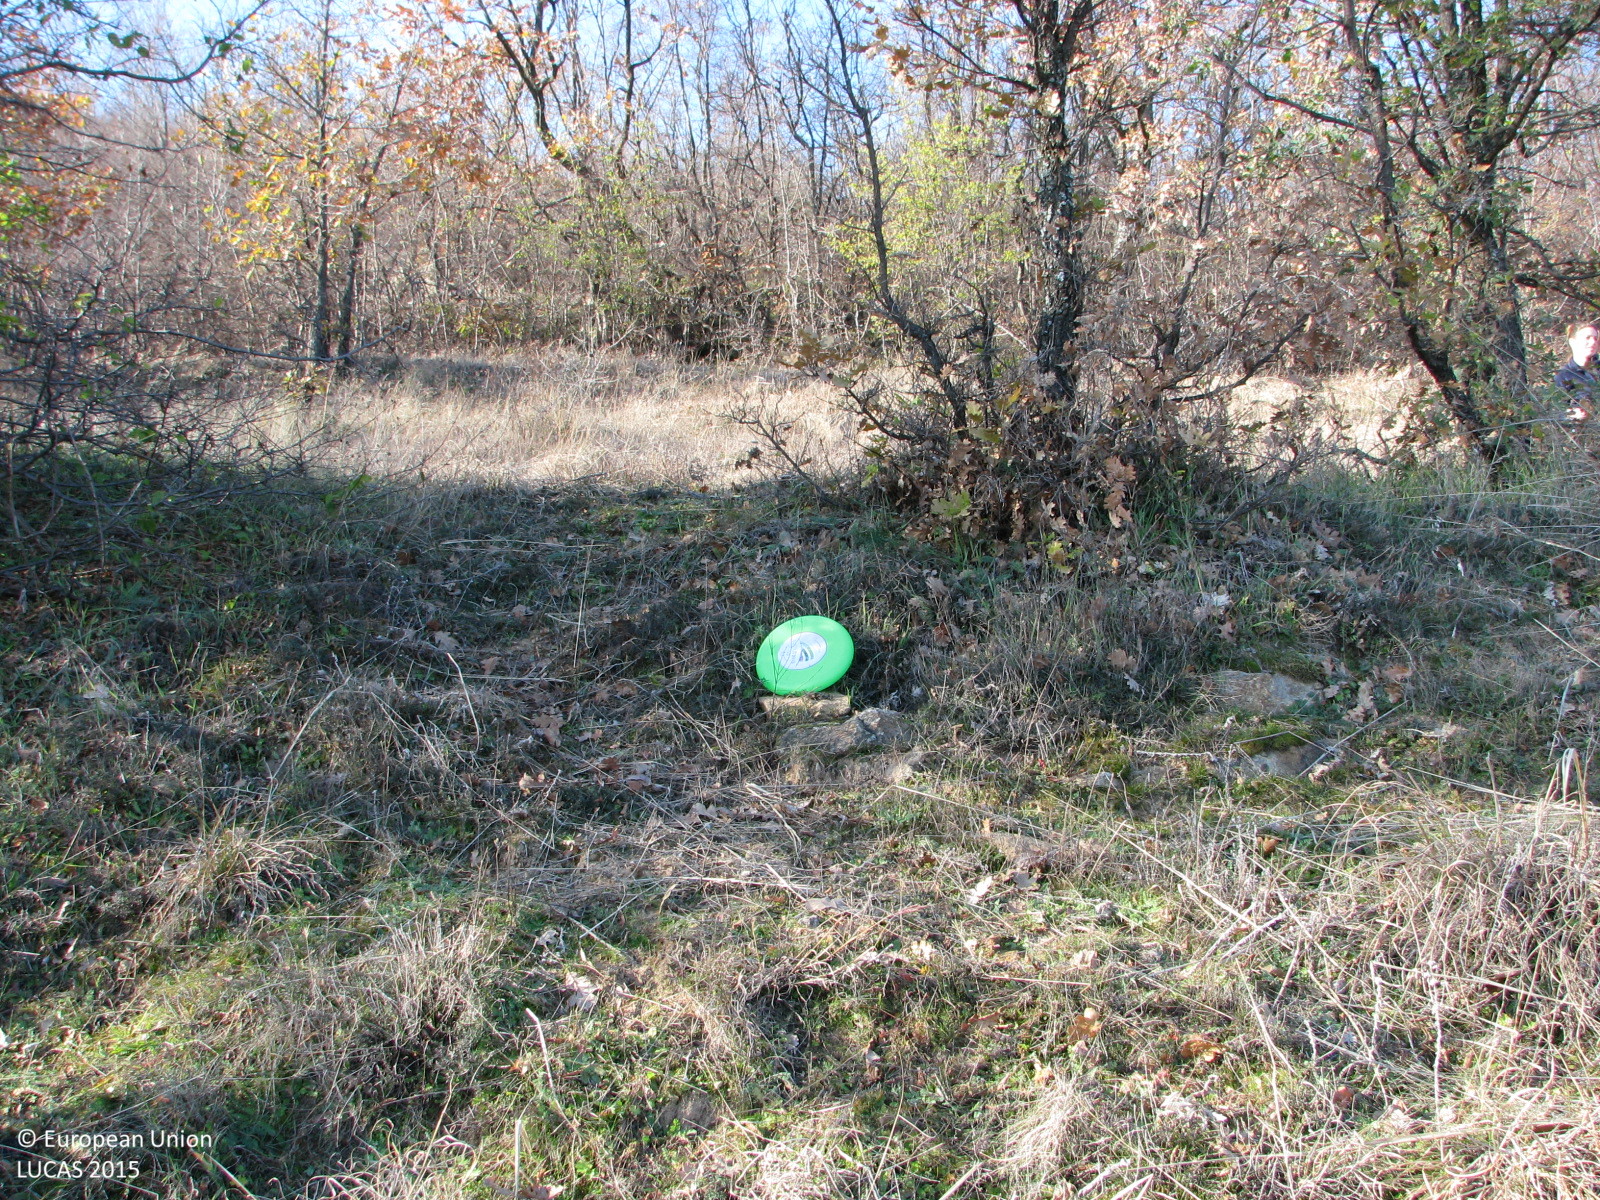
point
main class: Grassland
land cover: Grassland with sparse tree/shrub cover
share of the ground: > 75 %
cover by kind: herbaceous plants 90 %, broadleaved forest trees 5 %, shrubs 5 %
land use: Fallow land
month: December
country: BG
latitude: 42.4354
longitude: 25.0736
